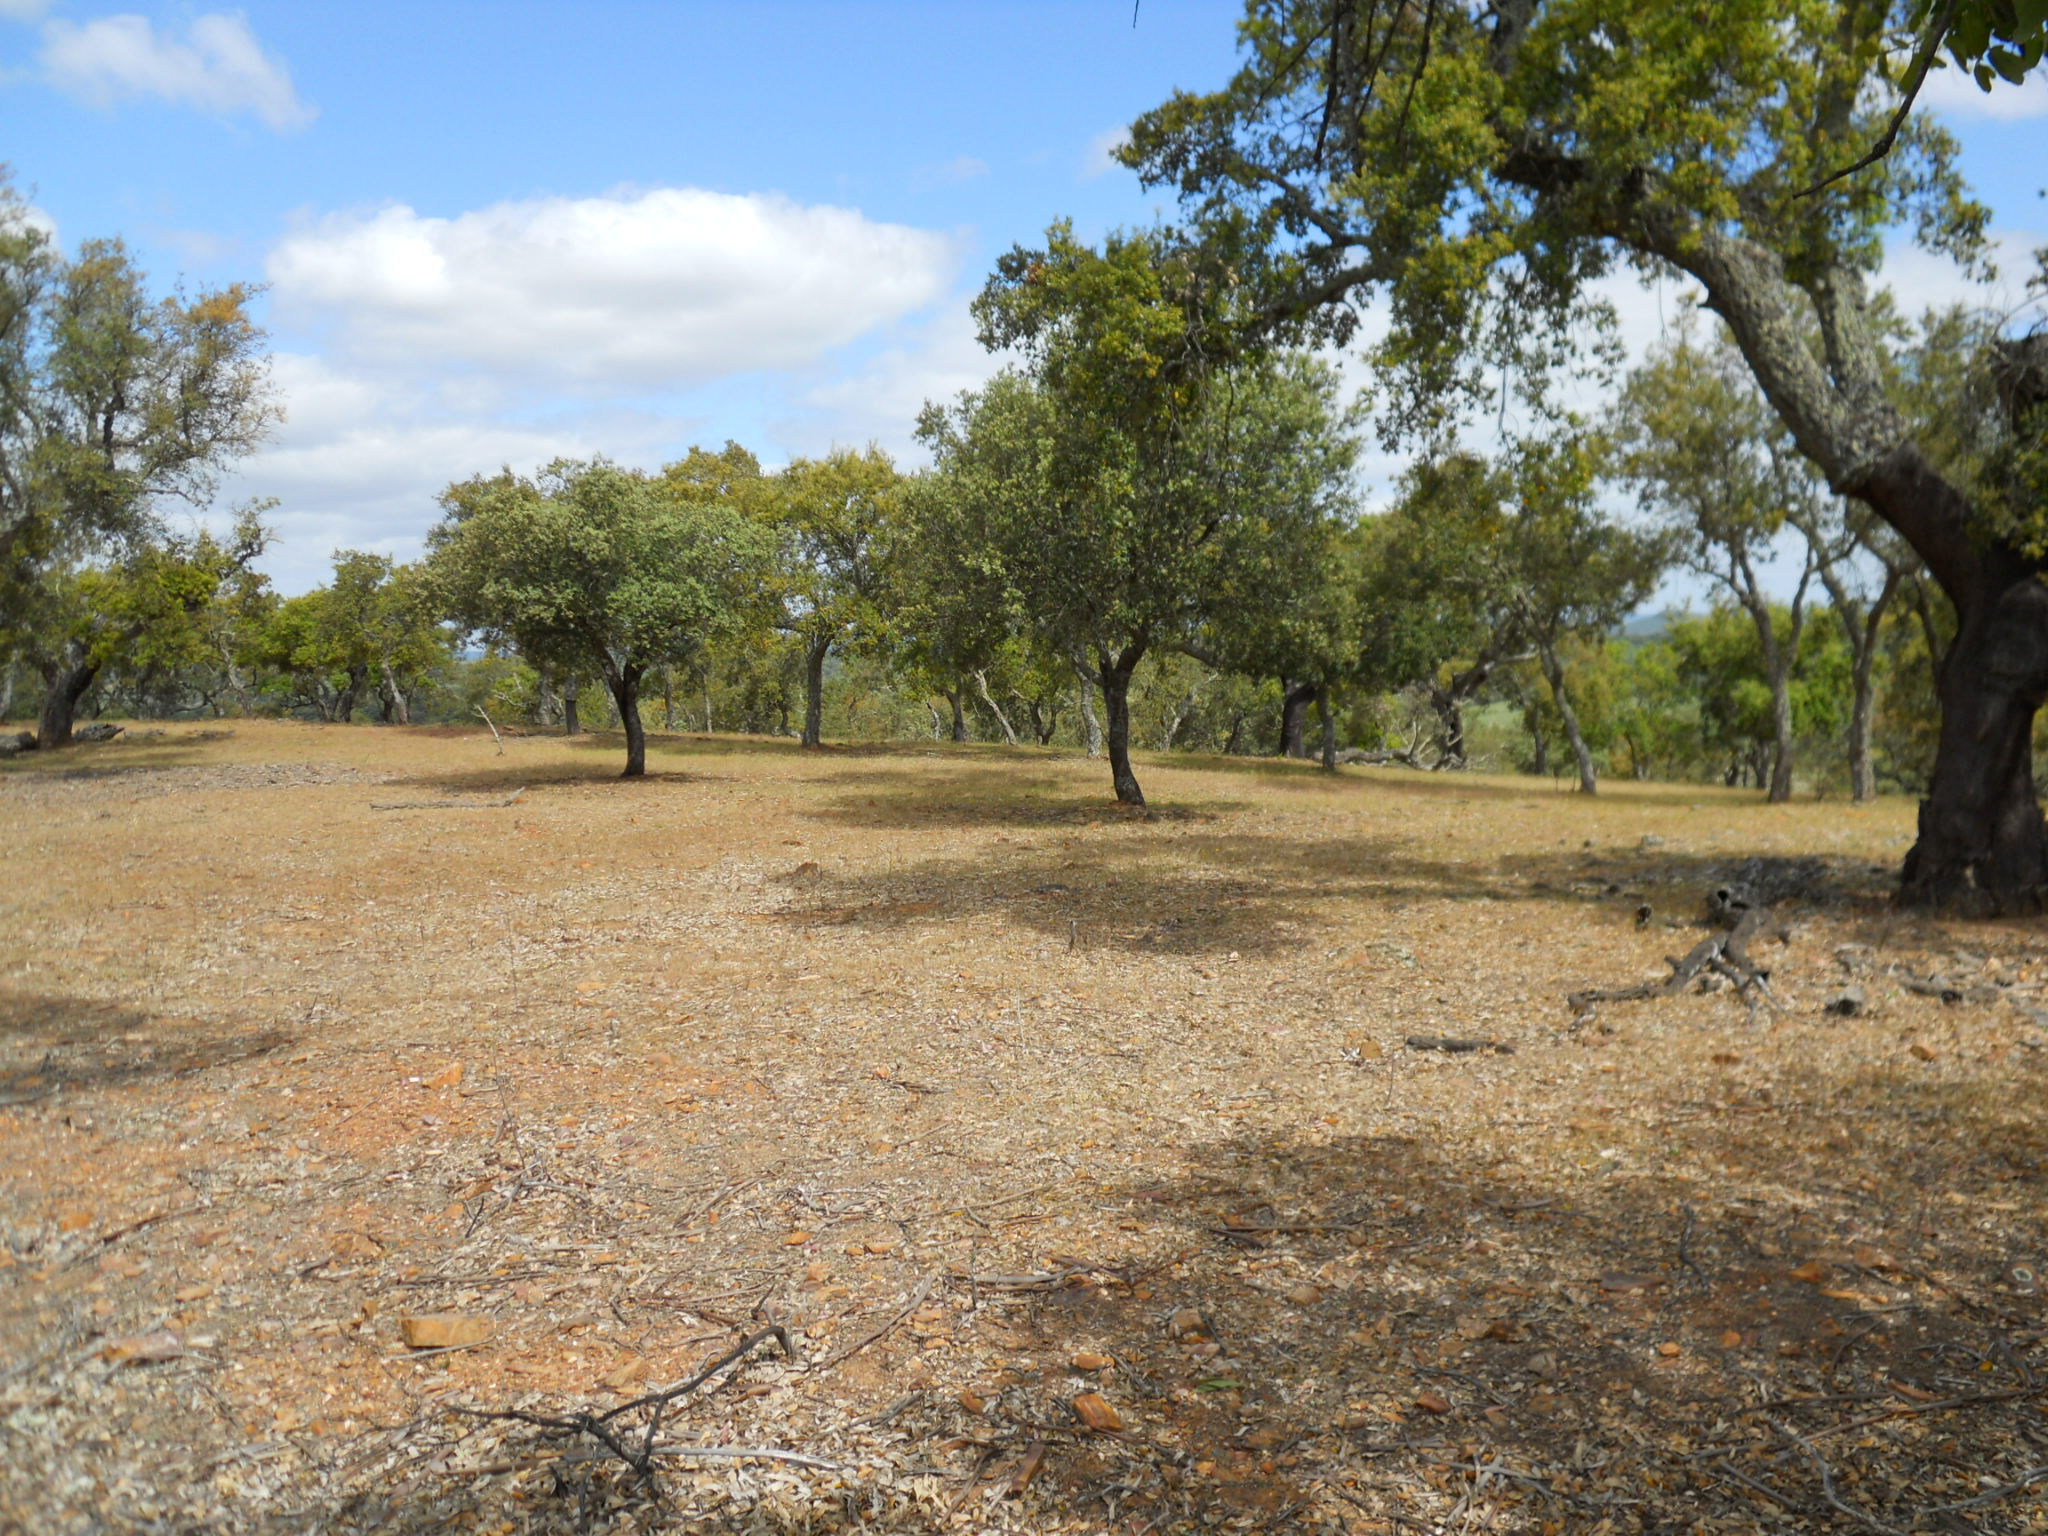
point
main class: Woodland
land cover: Broadleaved woodland
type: broadleaved evergreen forest
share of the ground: > 75 %
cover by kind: broadleaved forest trees 90 %, unconsolidated bare surface 10 %
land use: Forestry
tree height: > 5 m
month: May
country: ES
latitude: 39.1631
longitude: -7.0786
